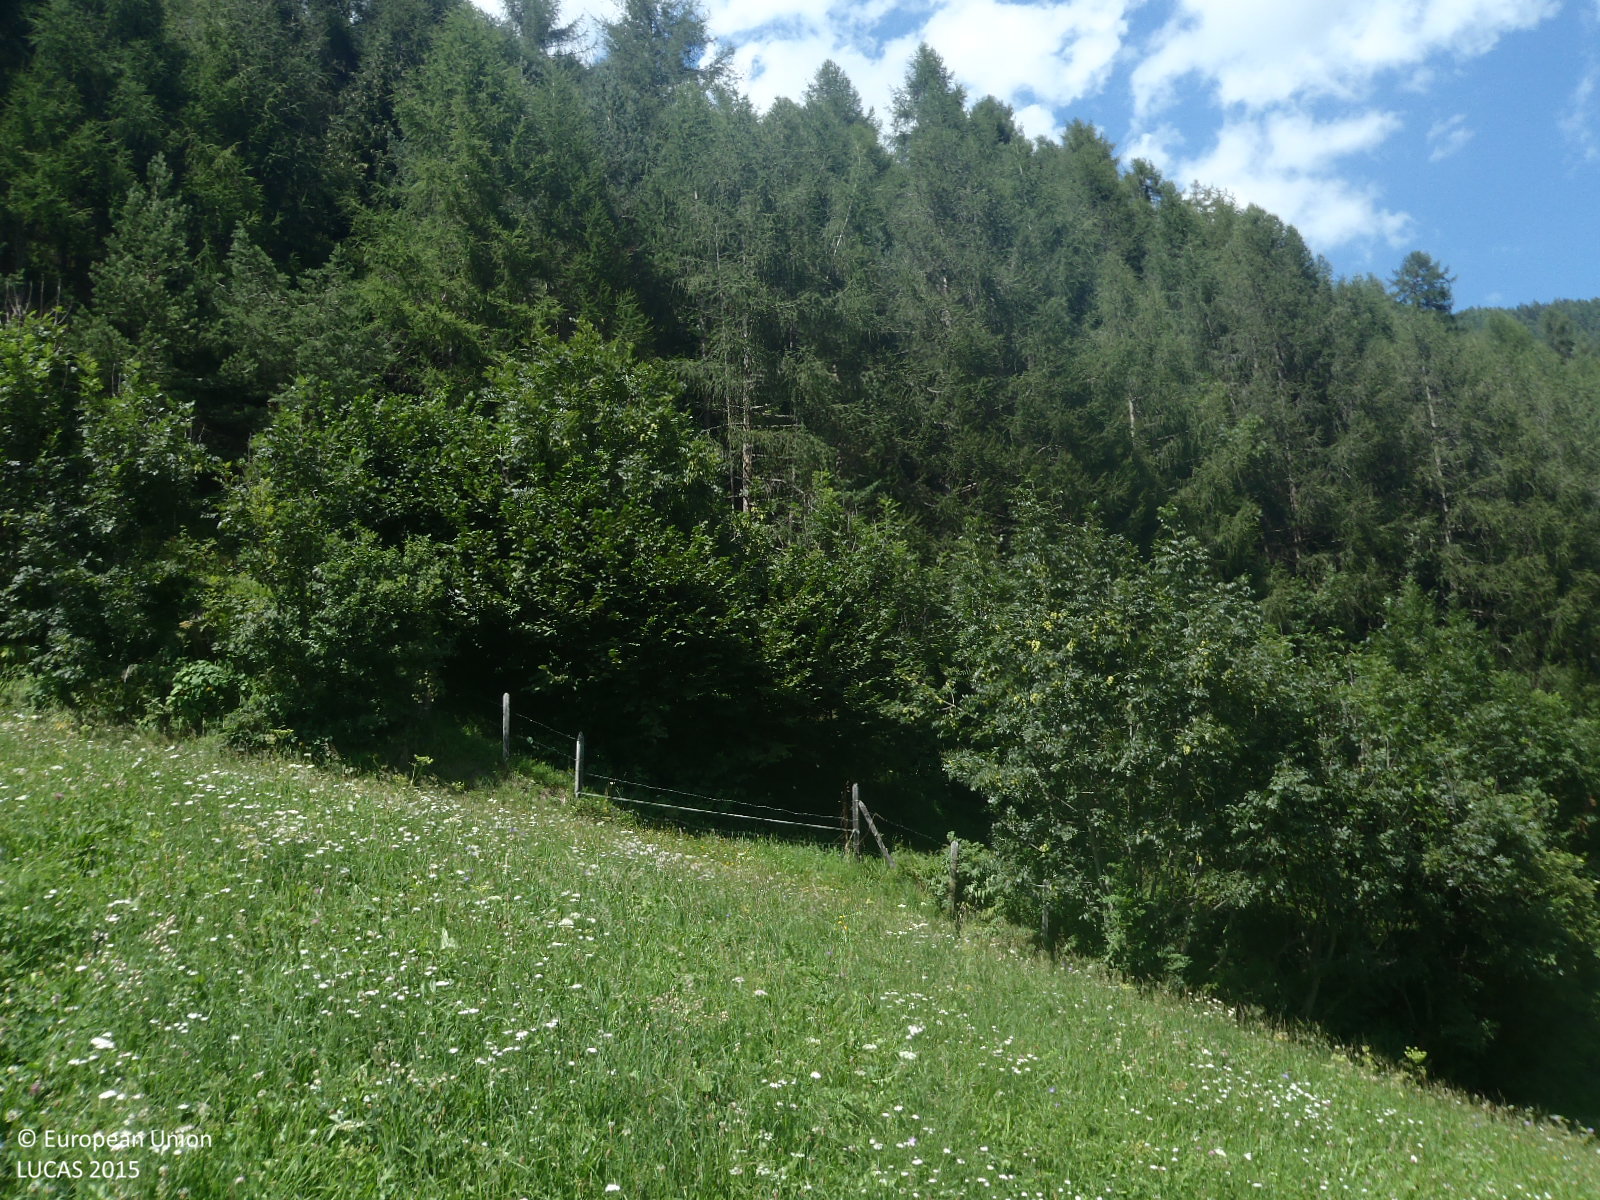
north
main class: Grassland
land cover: Grassland without tree/shrub cover
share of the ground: > 75 %
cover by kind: herbaceous plants 100 %
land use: Agriculture (excluding fallow land and kitchen gardens)
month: August
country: AT
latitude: 47.0082
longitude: 12.4312
